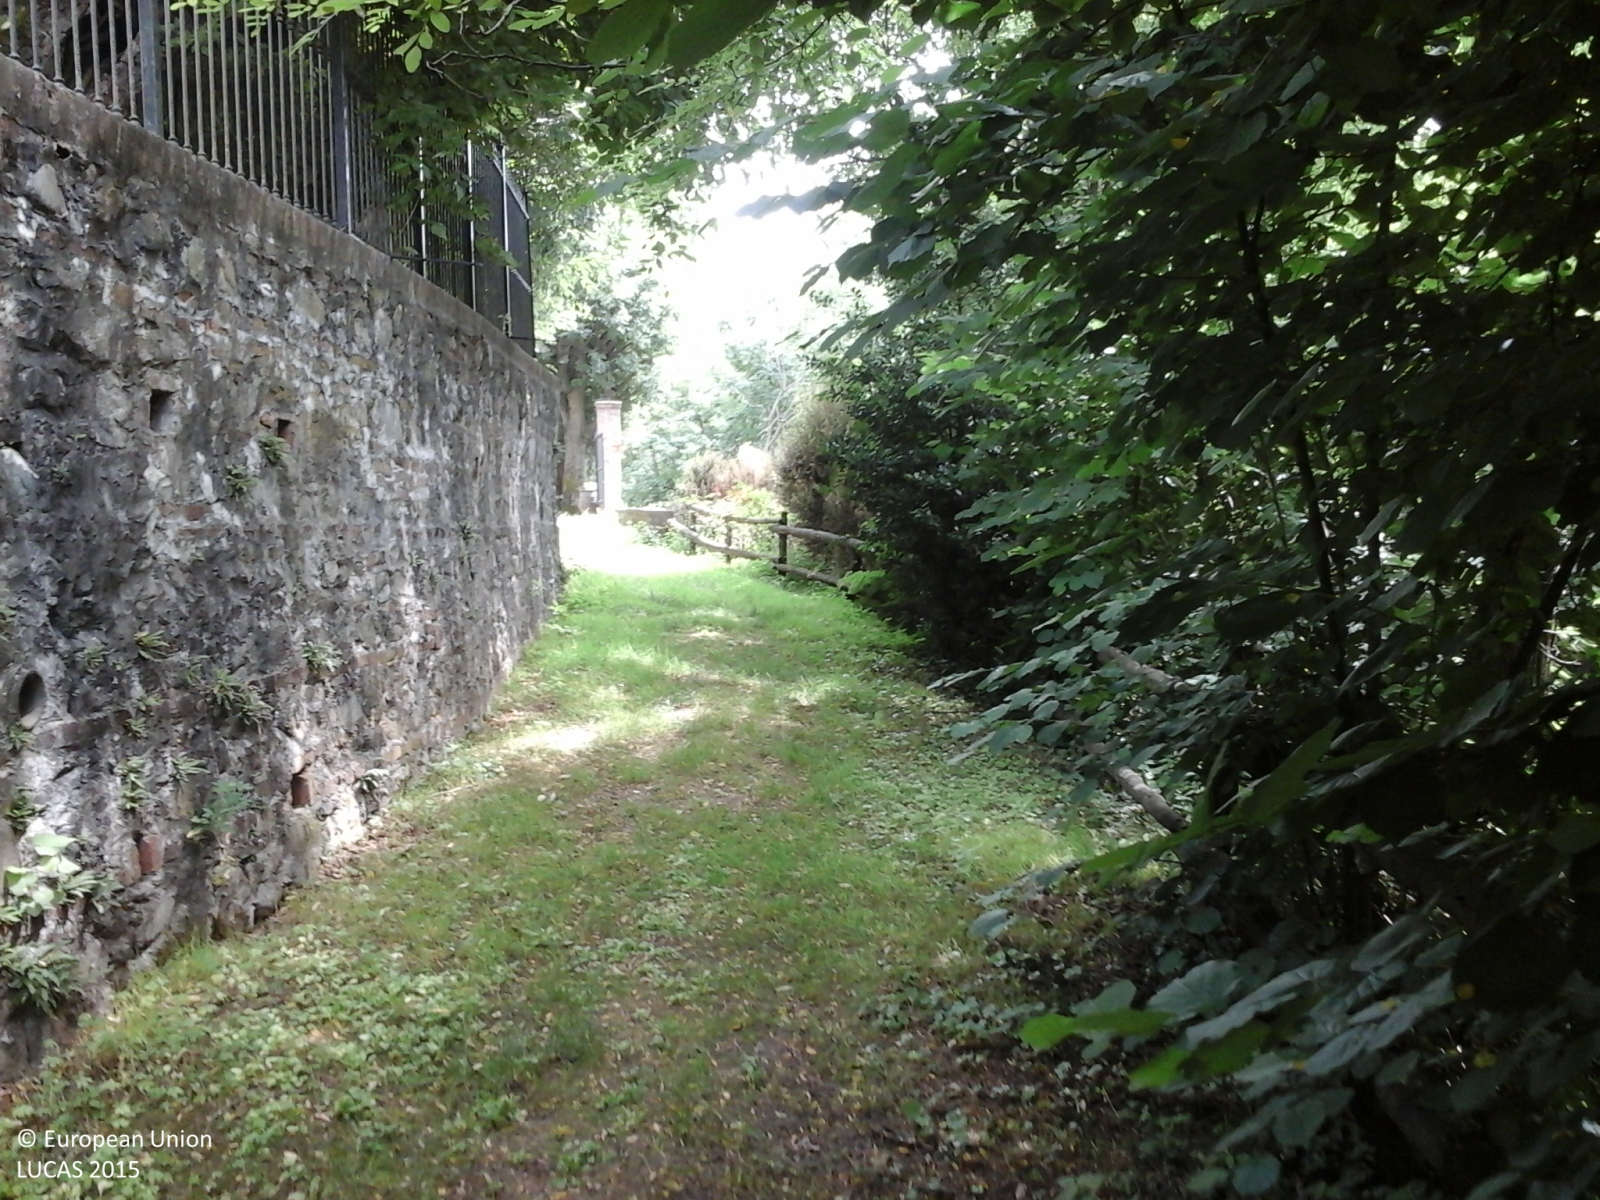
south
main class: Woodland
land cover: Broadleaved woodland
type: thermophilous deciduous forest
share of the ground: > 75 %
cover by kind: broadleaved forest trees 100 %
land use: Semi-natural and natural areas not in use
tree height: > 5 m
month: June
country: IT
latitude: 45.1024
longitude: 7.7799
